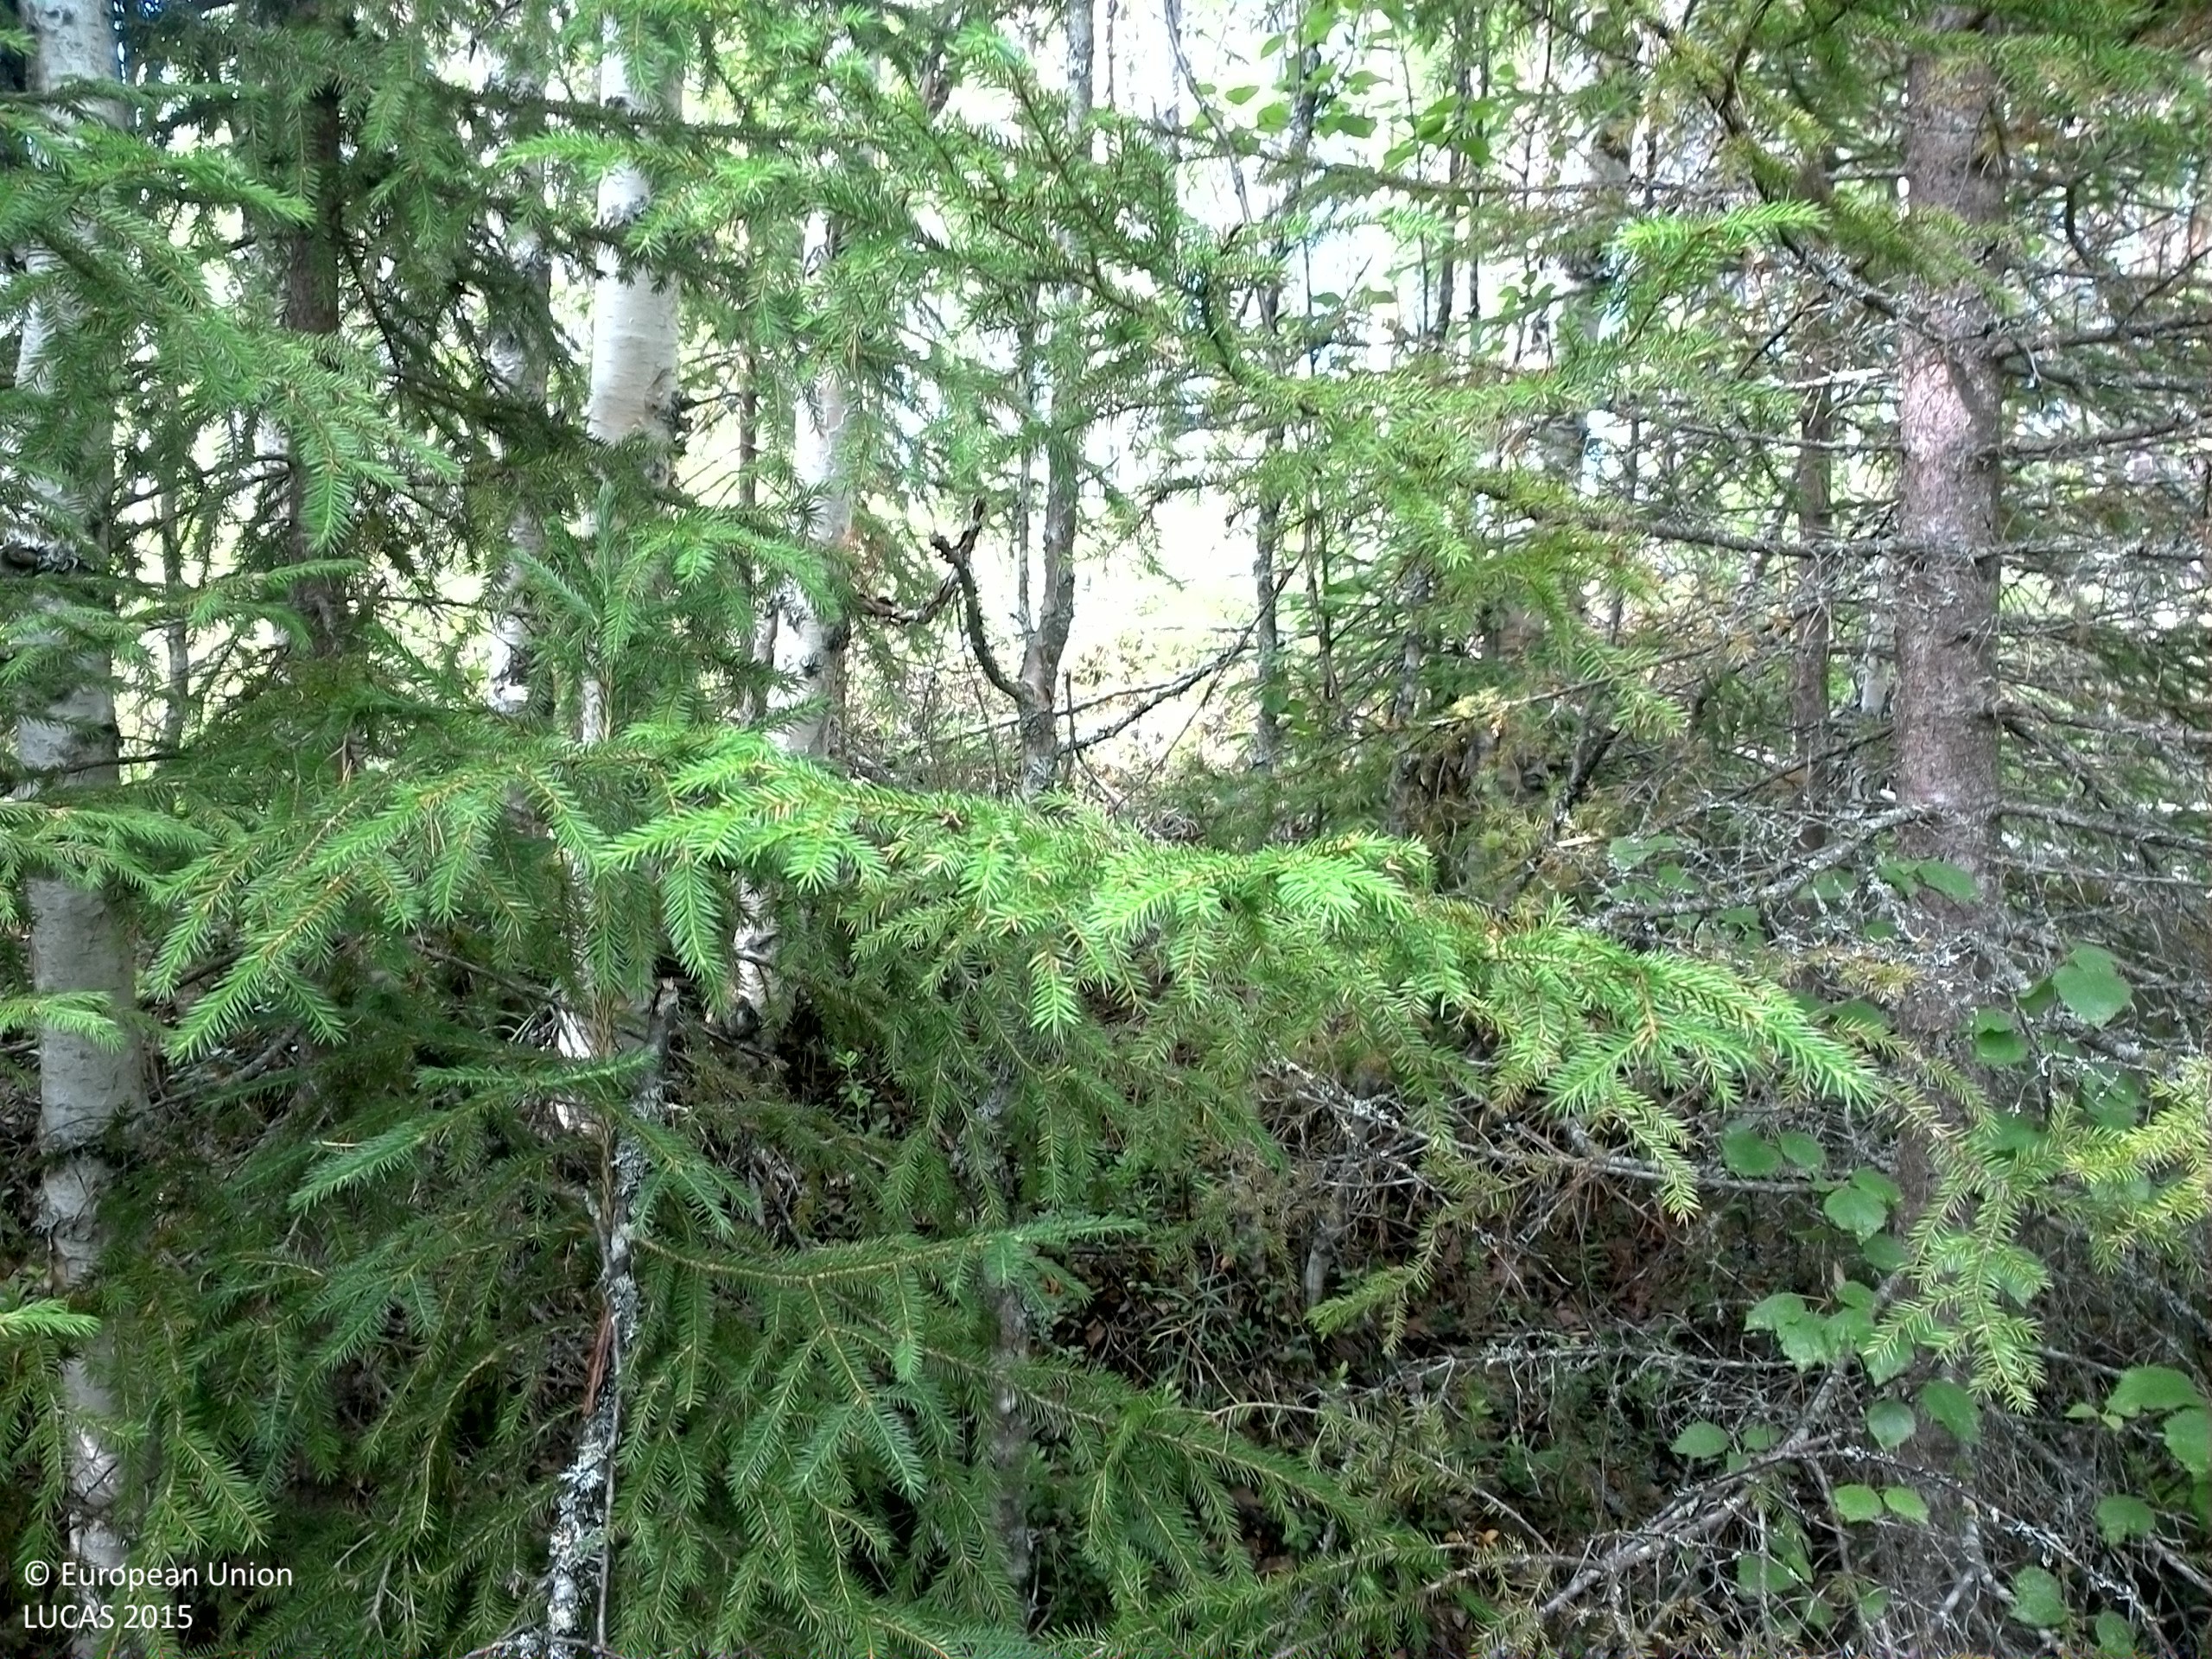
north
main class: Woodland
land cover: Other mixed woodland
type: boreal forest
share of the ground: > 75 %
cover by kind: broadleaved forest trees 45 %, coniferous forest trees 35 %, shrubs 10 %, lichens and mosses 5 %, unconsolidated bare surface 5 %
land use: Forestry
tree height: > 5 m
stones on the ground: < 10 %
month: July
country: SE
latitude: 64.4532
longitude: 15.8510
